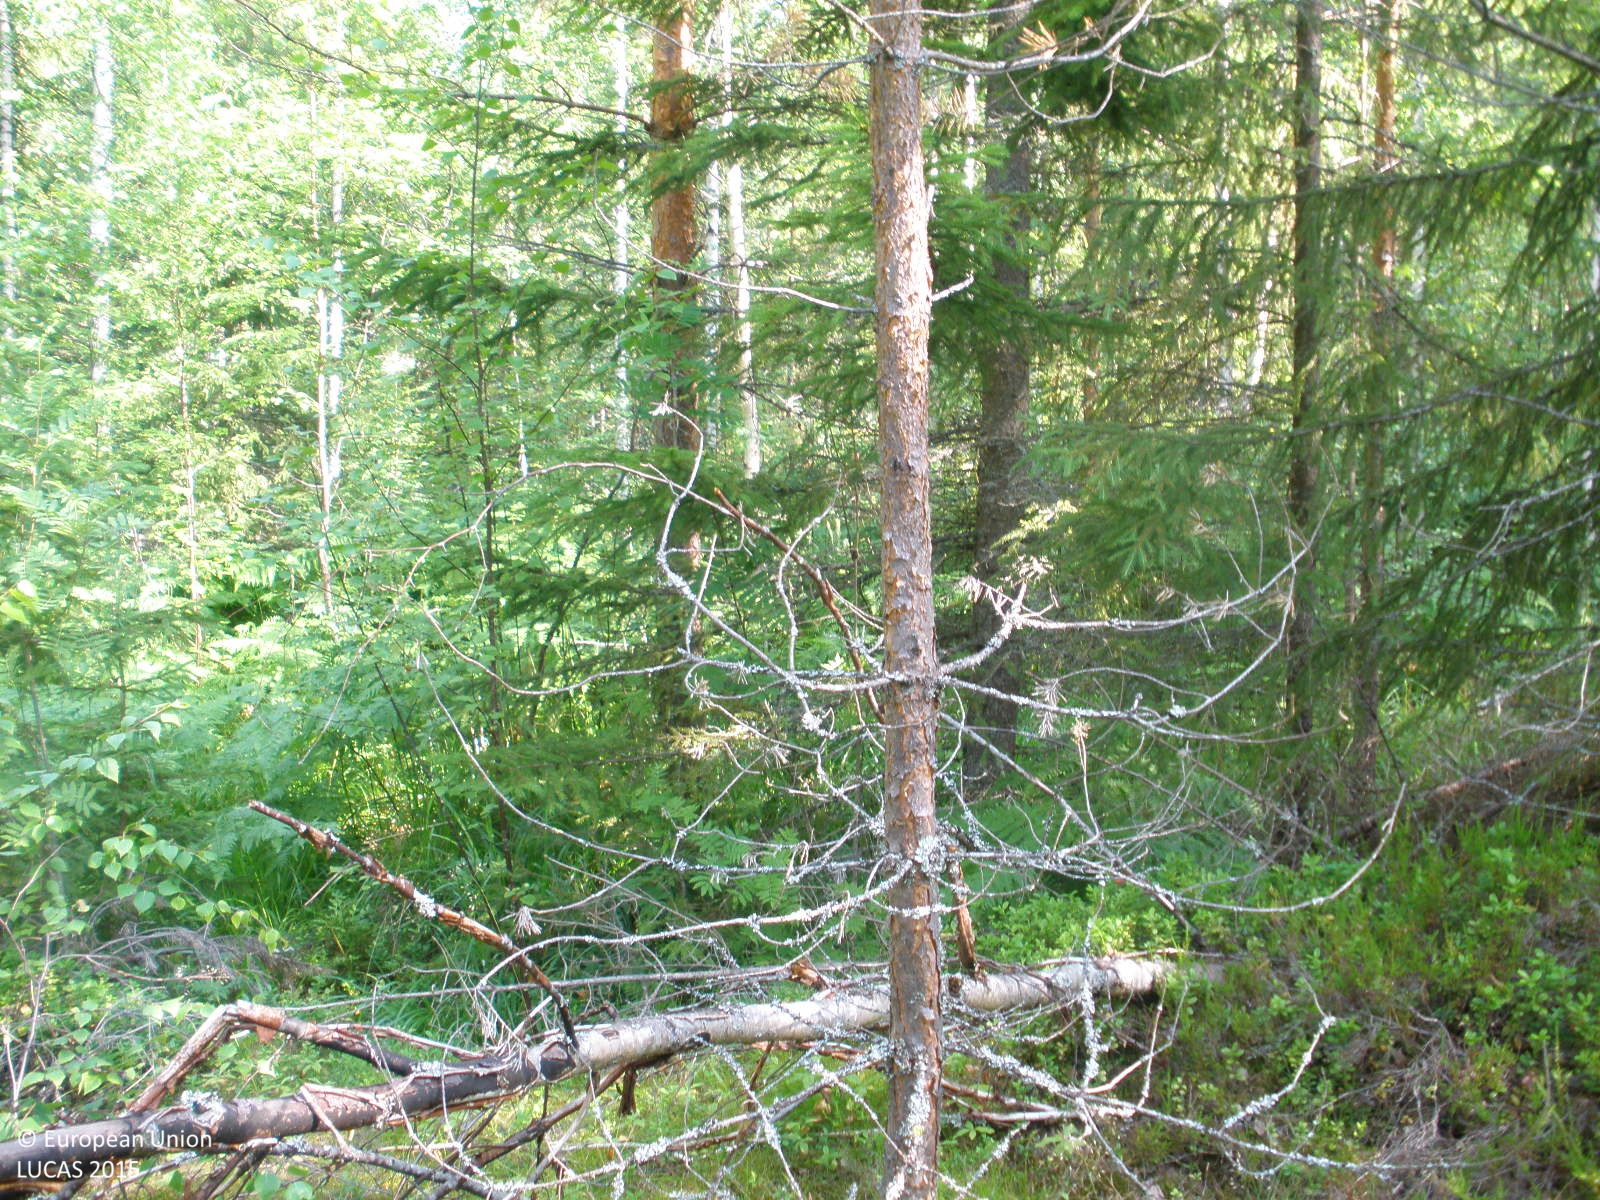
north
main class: Woodland
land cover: Spruce dominated mixed woodland
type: boreal forest
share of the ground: 50 - 75 %
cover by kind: coniferous forest trees 40 %, broadleaved forest trees 25 %, herbaceous plants 20 %, shrubs 10 %, lichens and mosses 5 %
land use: Forestry
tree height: > 5 m
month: July
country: FI
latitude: 61.5766
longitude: 24.6592
